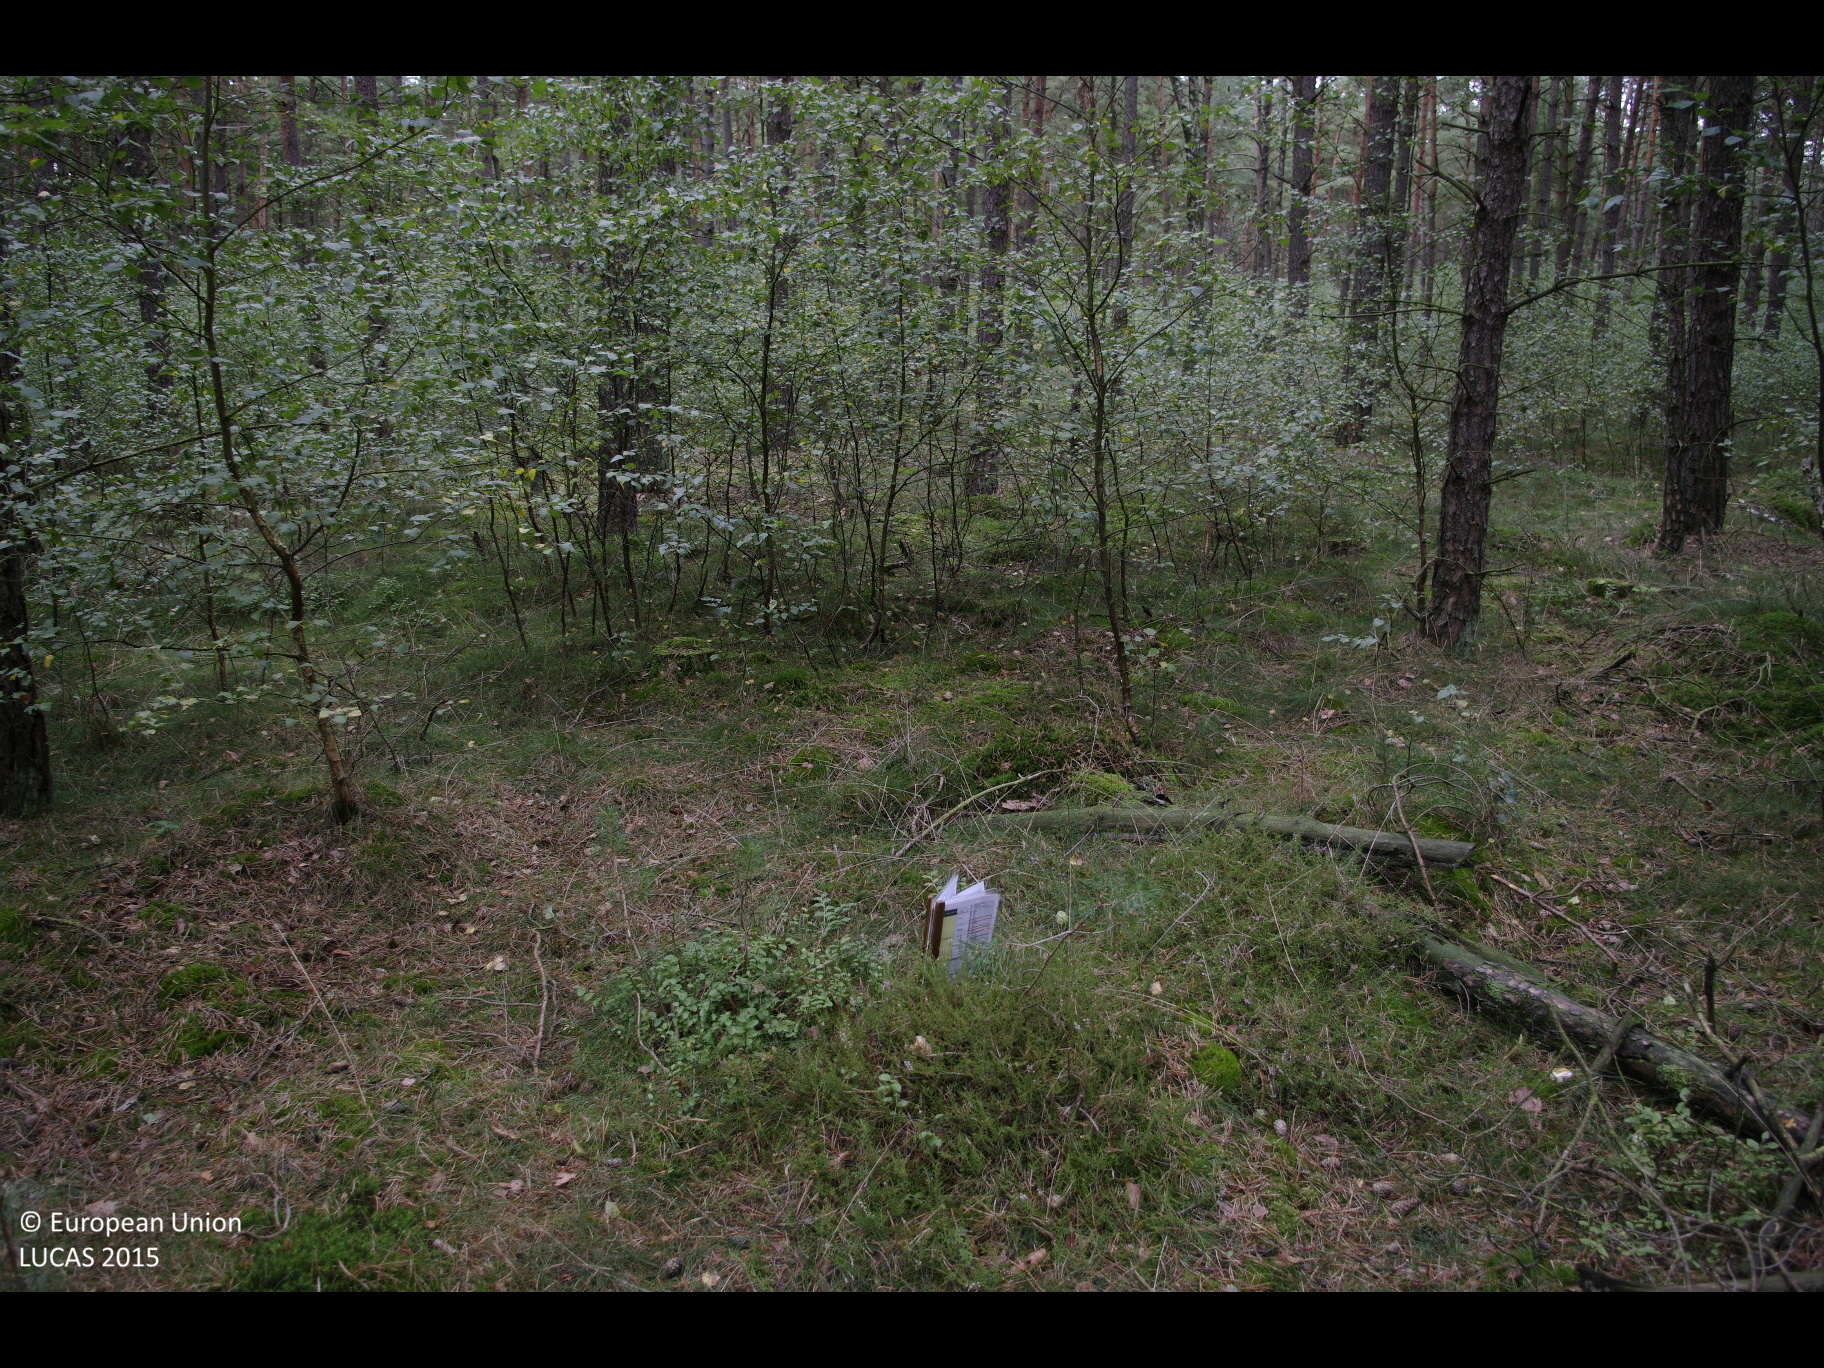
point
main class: Woodland
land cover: Pine dominated mixed woodland
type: hemiboreal forest and nemoral coniferous forest and mixed broadleaved-coniferous forest
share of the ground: 50 - 75 %
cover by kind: coniferous forest trees 40 %, broadleaved forest trees 30 %, herbaceous plants 30 %
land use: Forestry
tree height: > 5 m
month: September
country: DE
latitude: 53.0424
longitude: 9.8658
